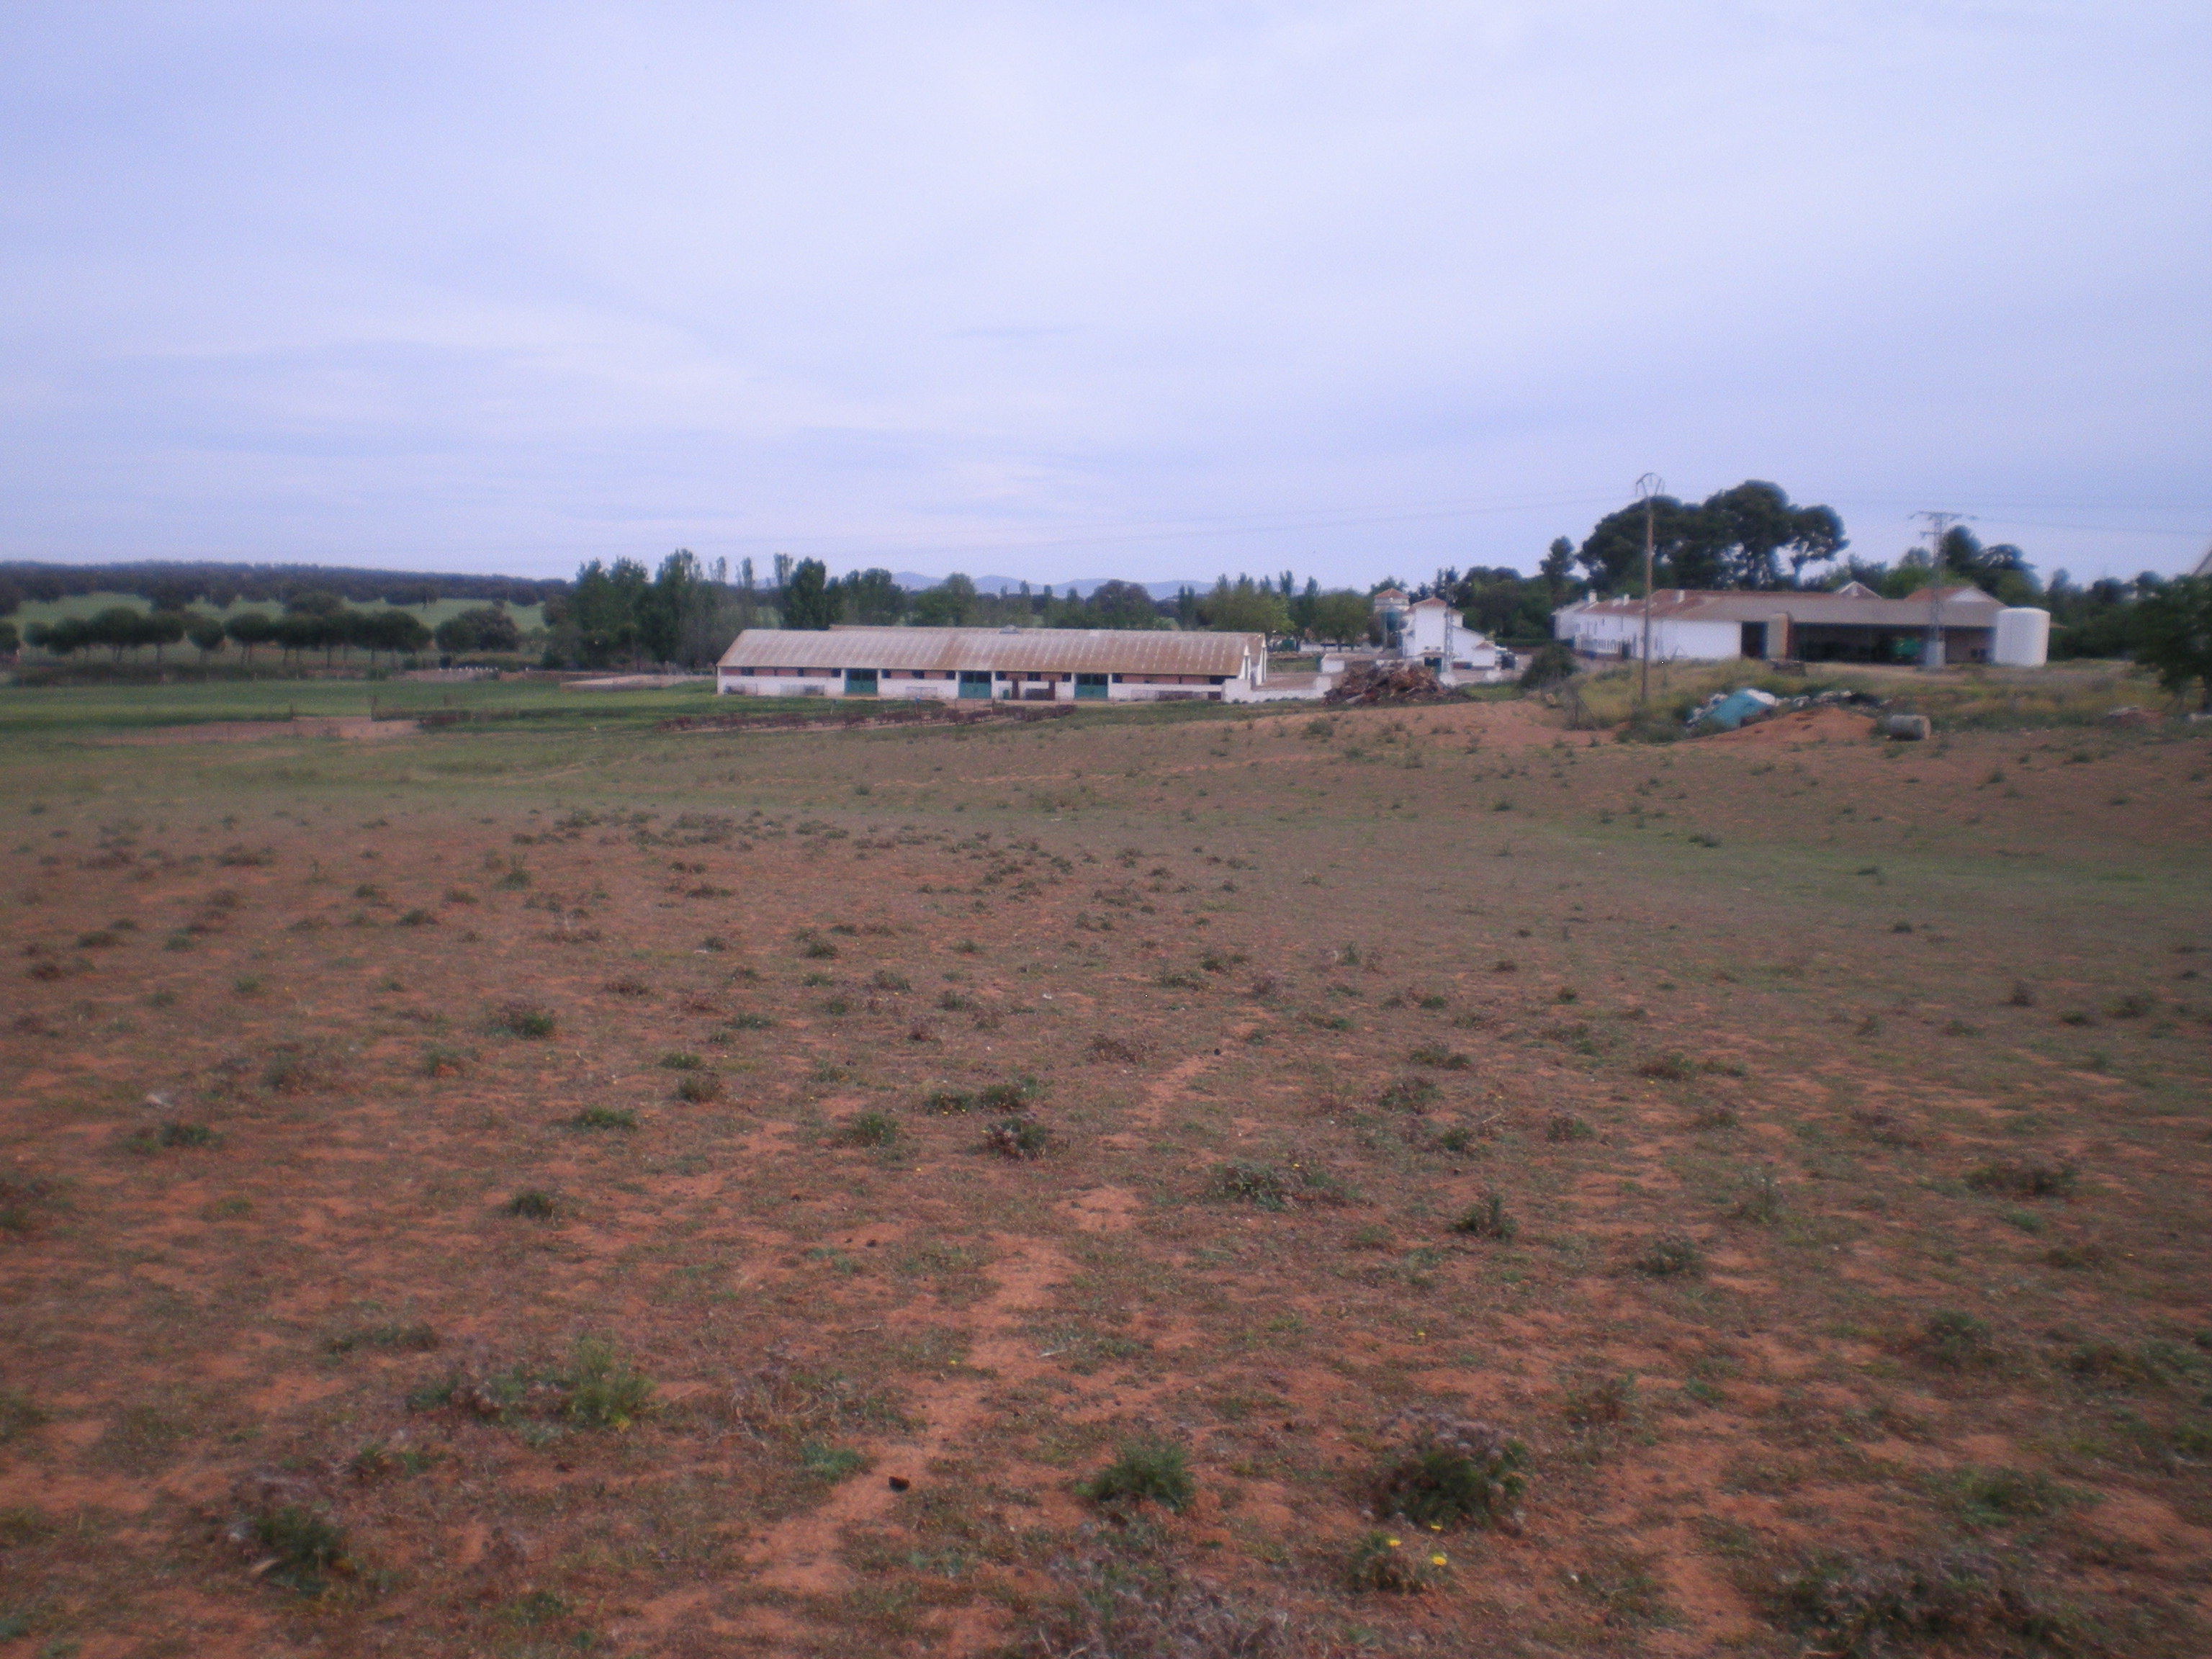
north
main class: Grassland
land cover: Spontaneously vegetated surfaces
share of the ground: 25 - 50 %
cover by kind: unconsolidated bare surface 75 %, herbaceous plants 25 %
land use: Agriculture (excluding fallow land and kitchen gardens)
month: May
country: ES
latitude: 38.6615
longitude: -3.1658
